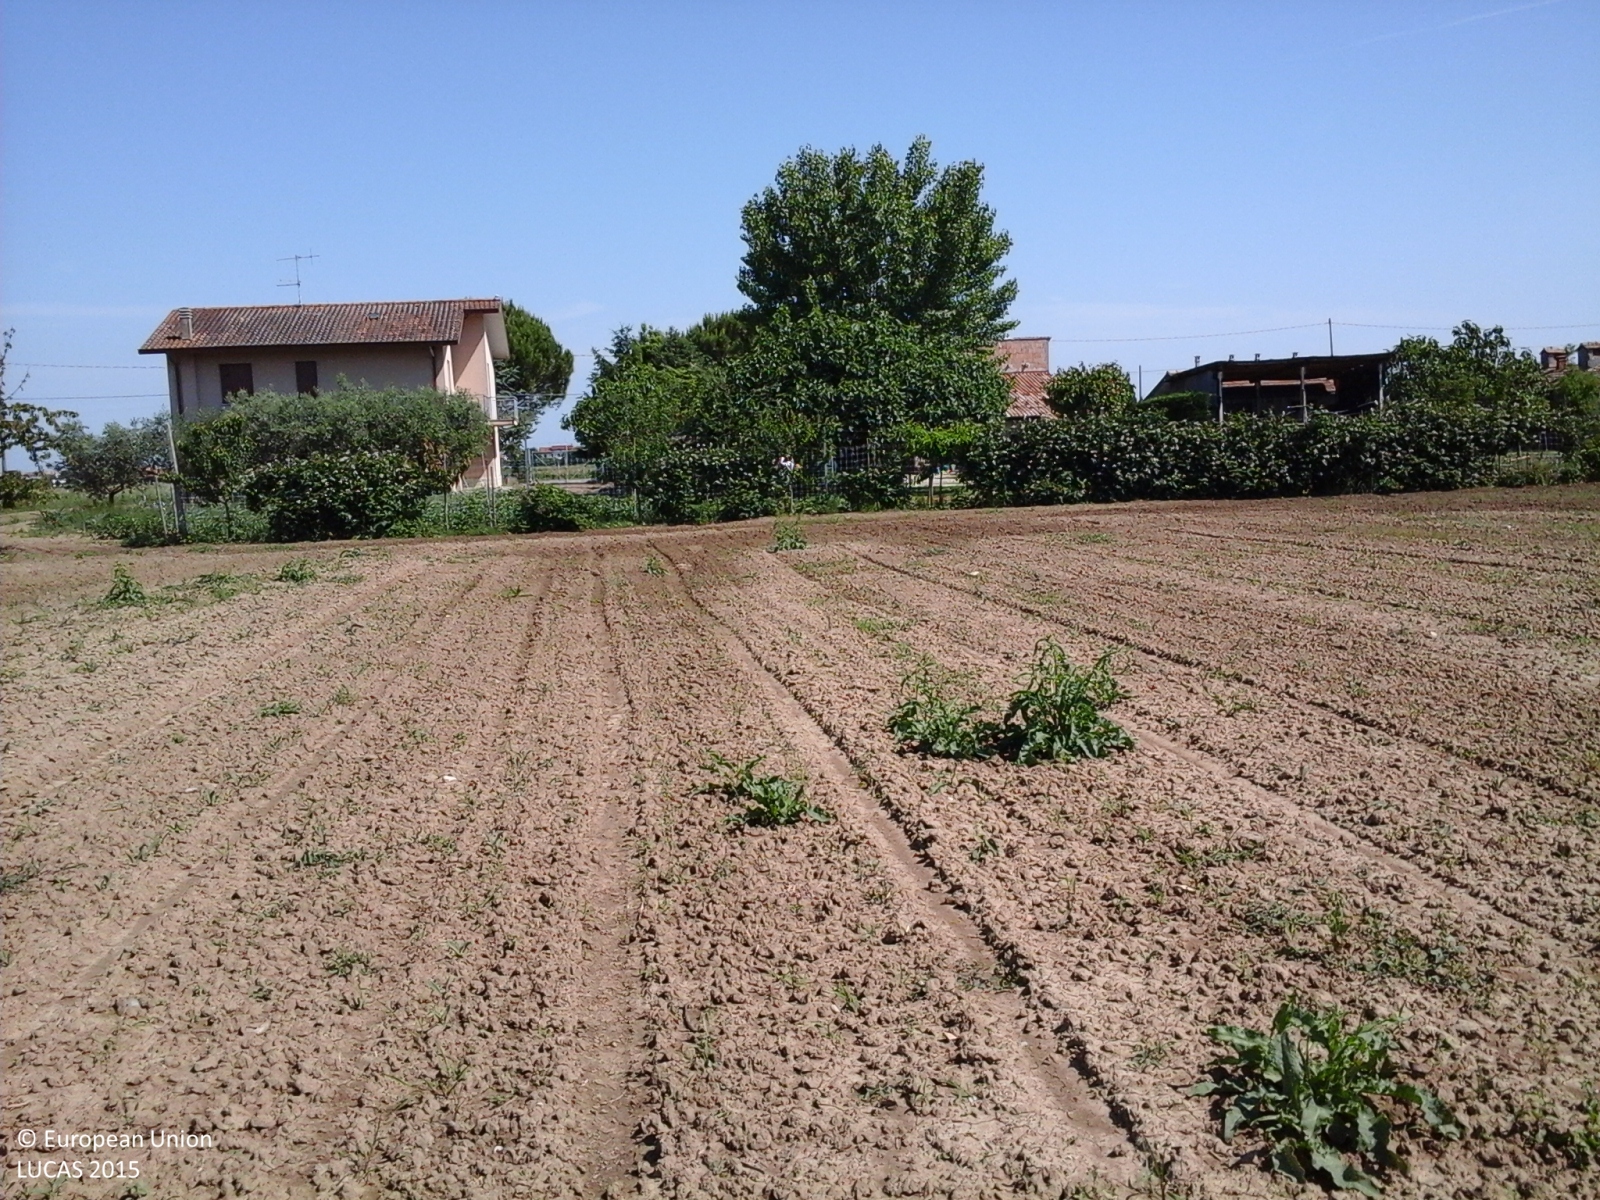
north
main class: Cropland
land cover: Other fresh vegetables
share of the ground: > 75 %
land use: Agriculture (excluding fallow land and kitchen gardens)
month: May
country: IT
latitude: 44.0875
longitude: 12.4299
